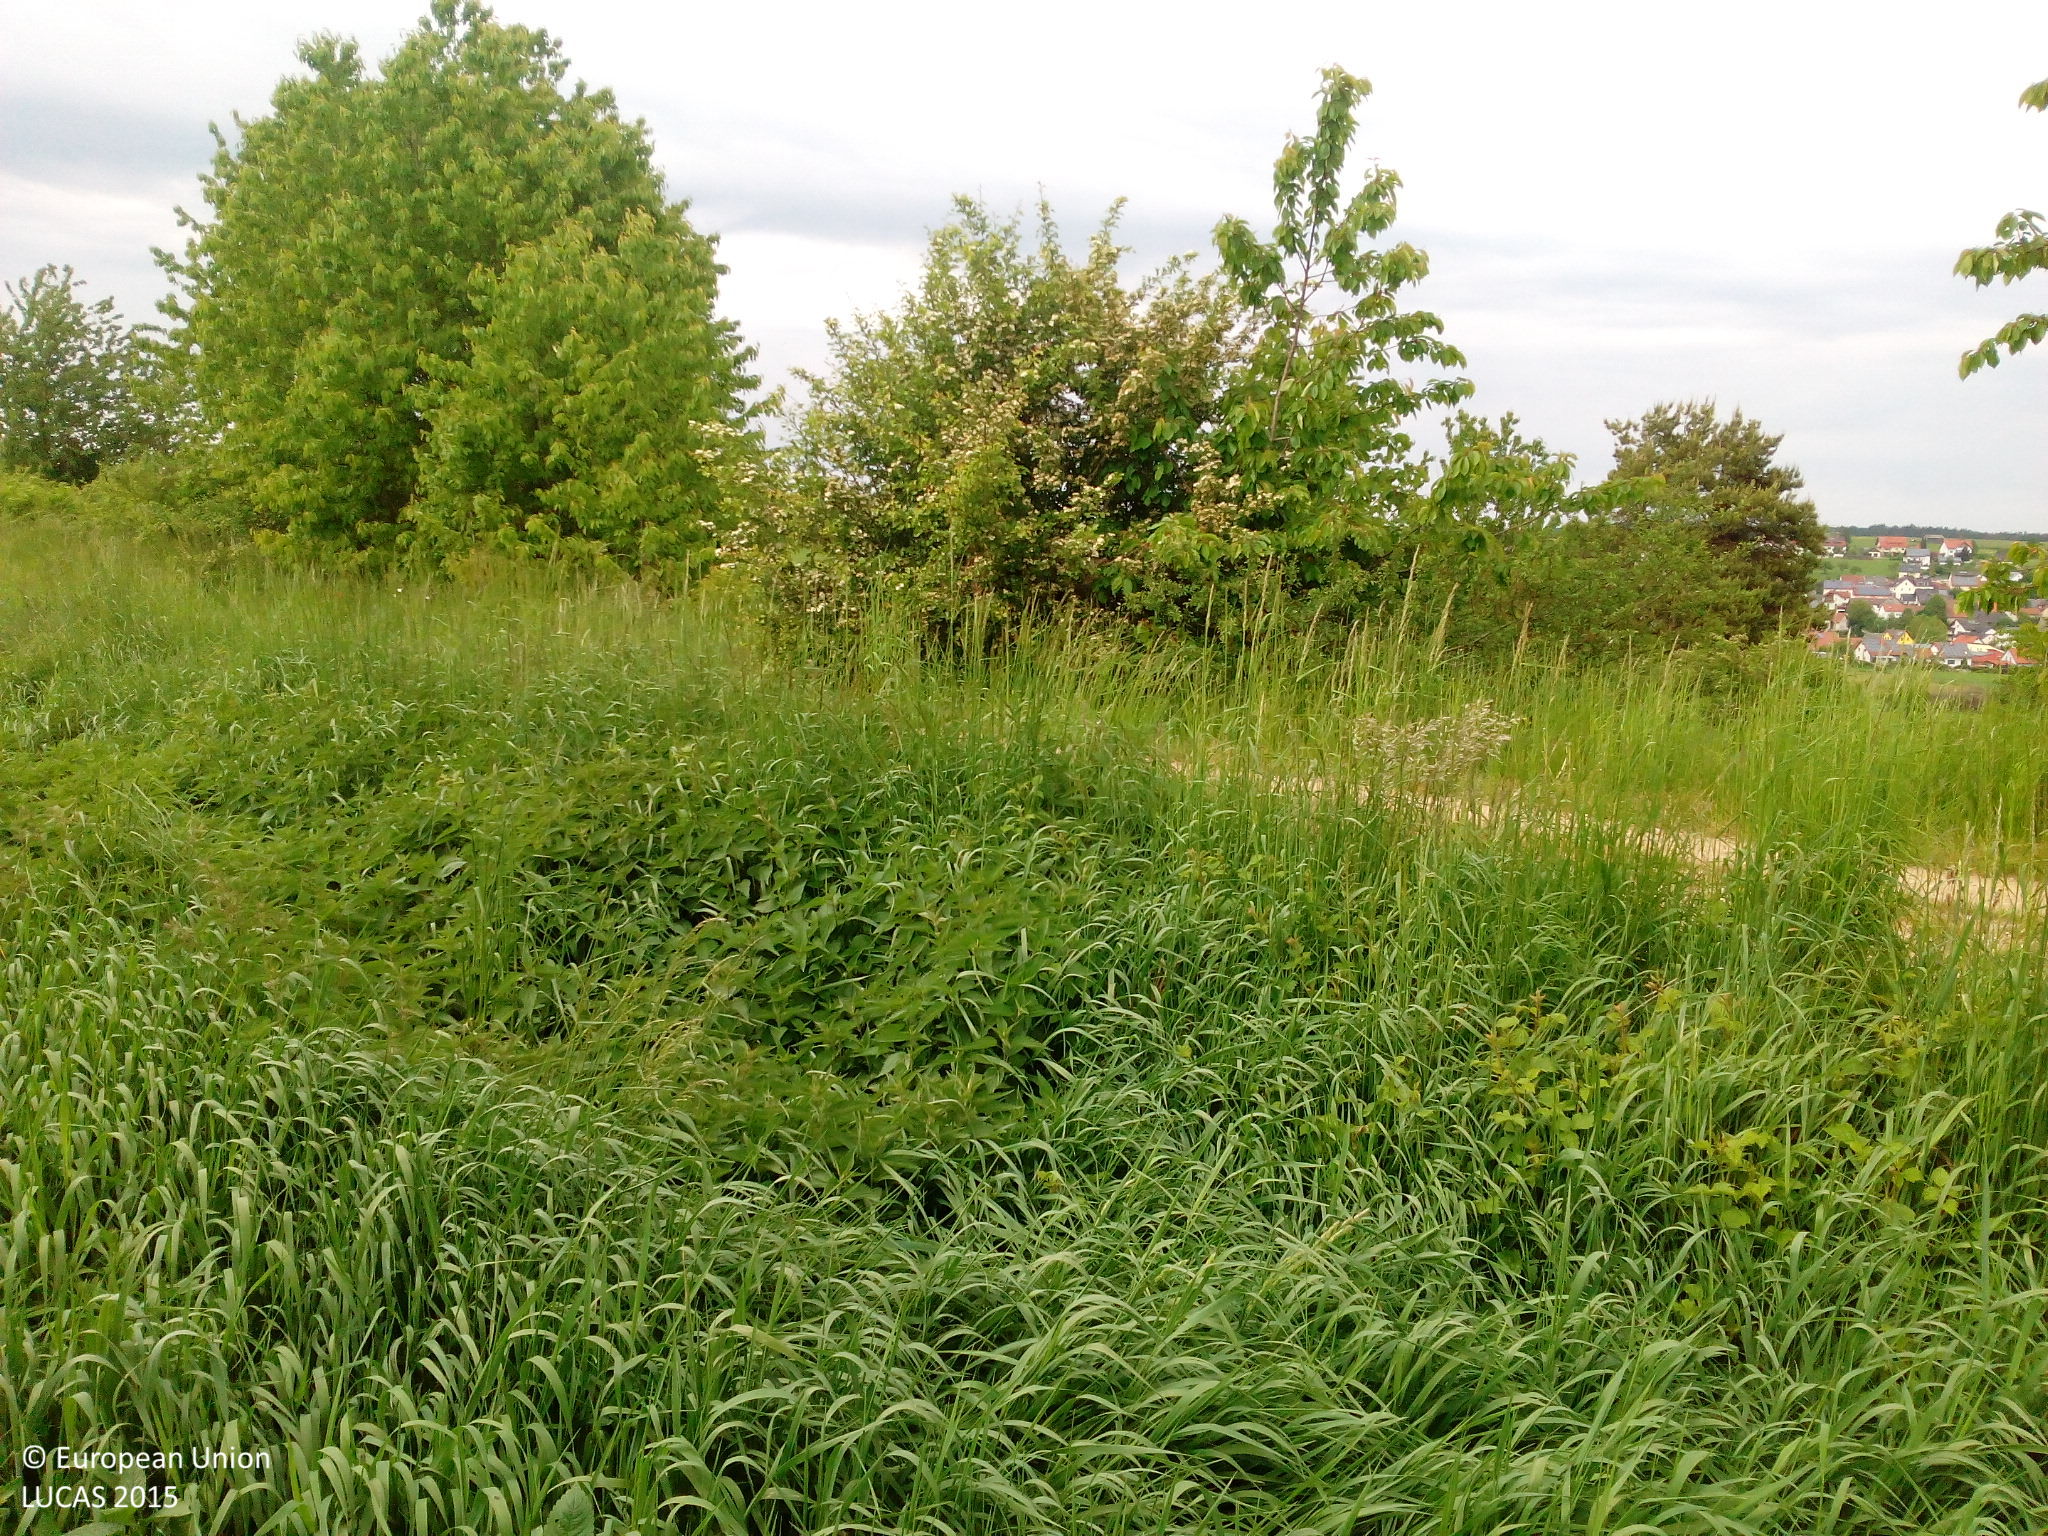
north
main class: Cropland
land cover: Rape and turnip rape
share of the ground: > 75 %
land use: Agriculture (excluding fallow land and kitchen gardens)
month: May
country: DE
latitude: 49.7594
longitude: 11.5960
